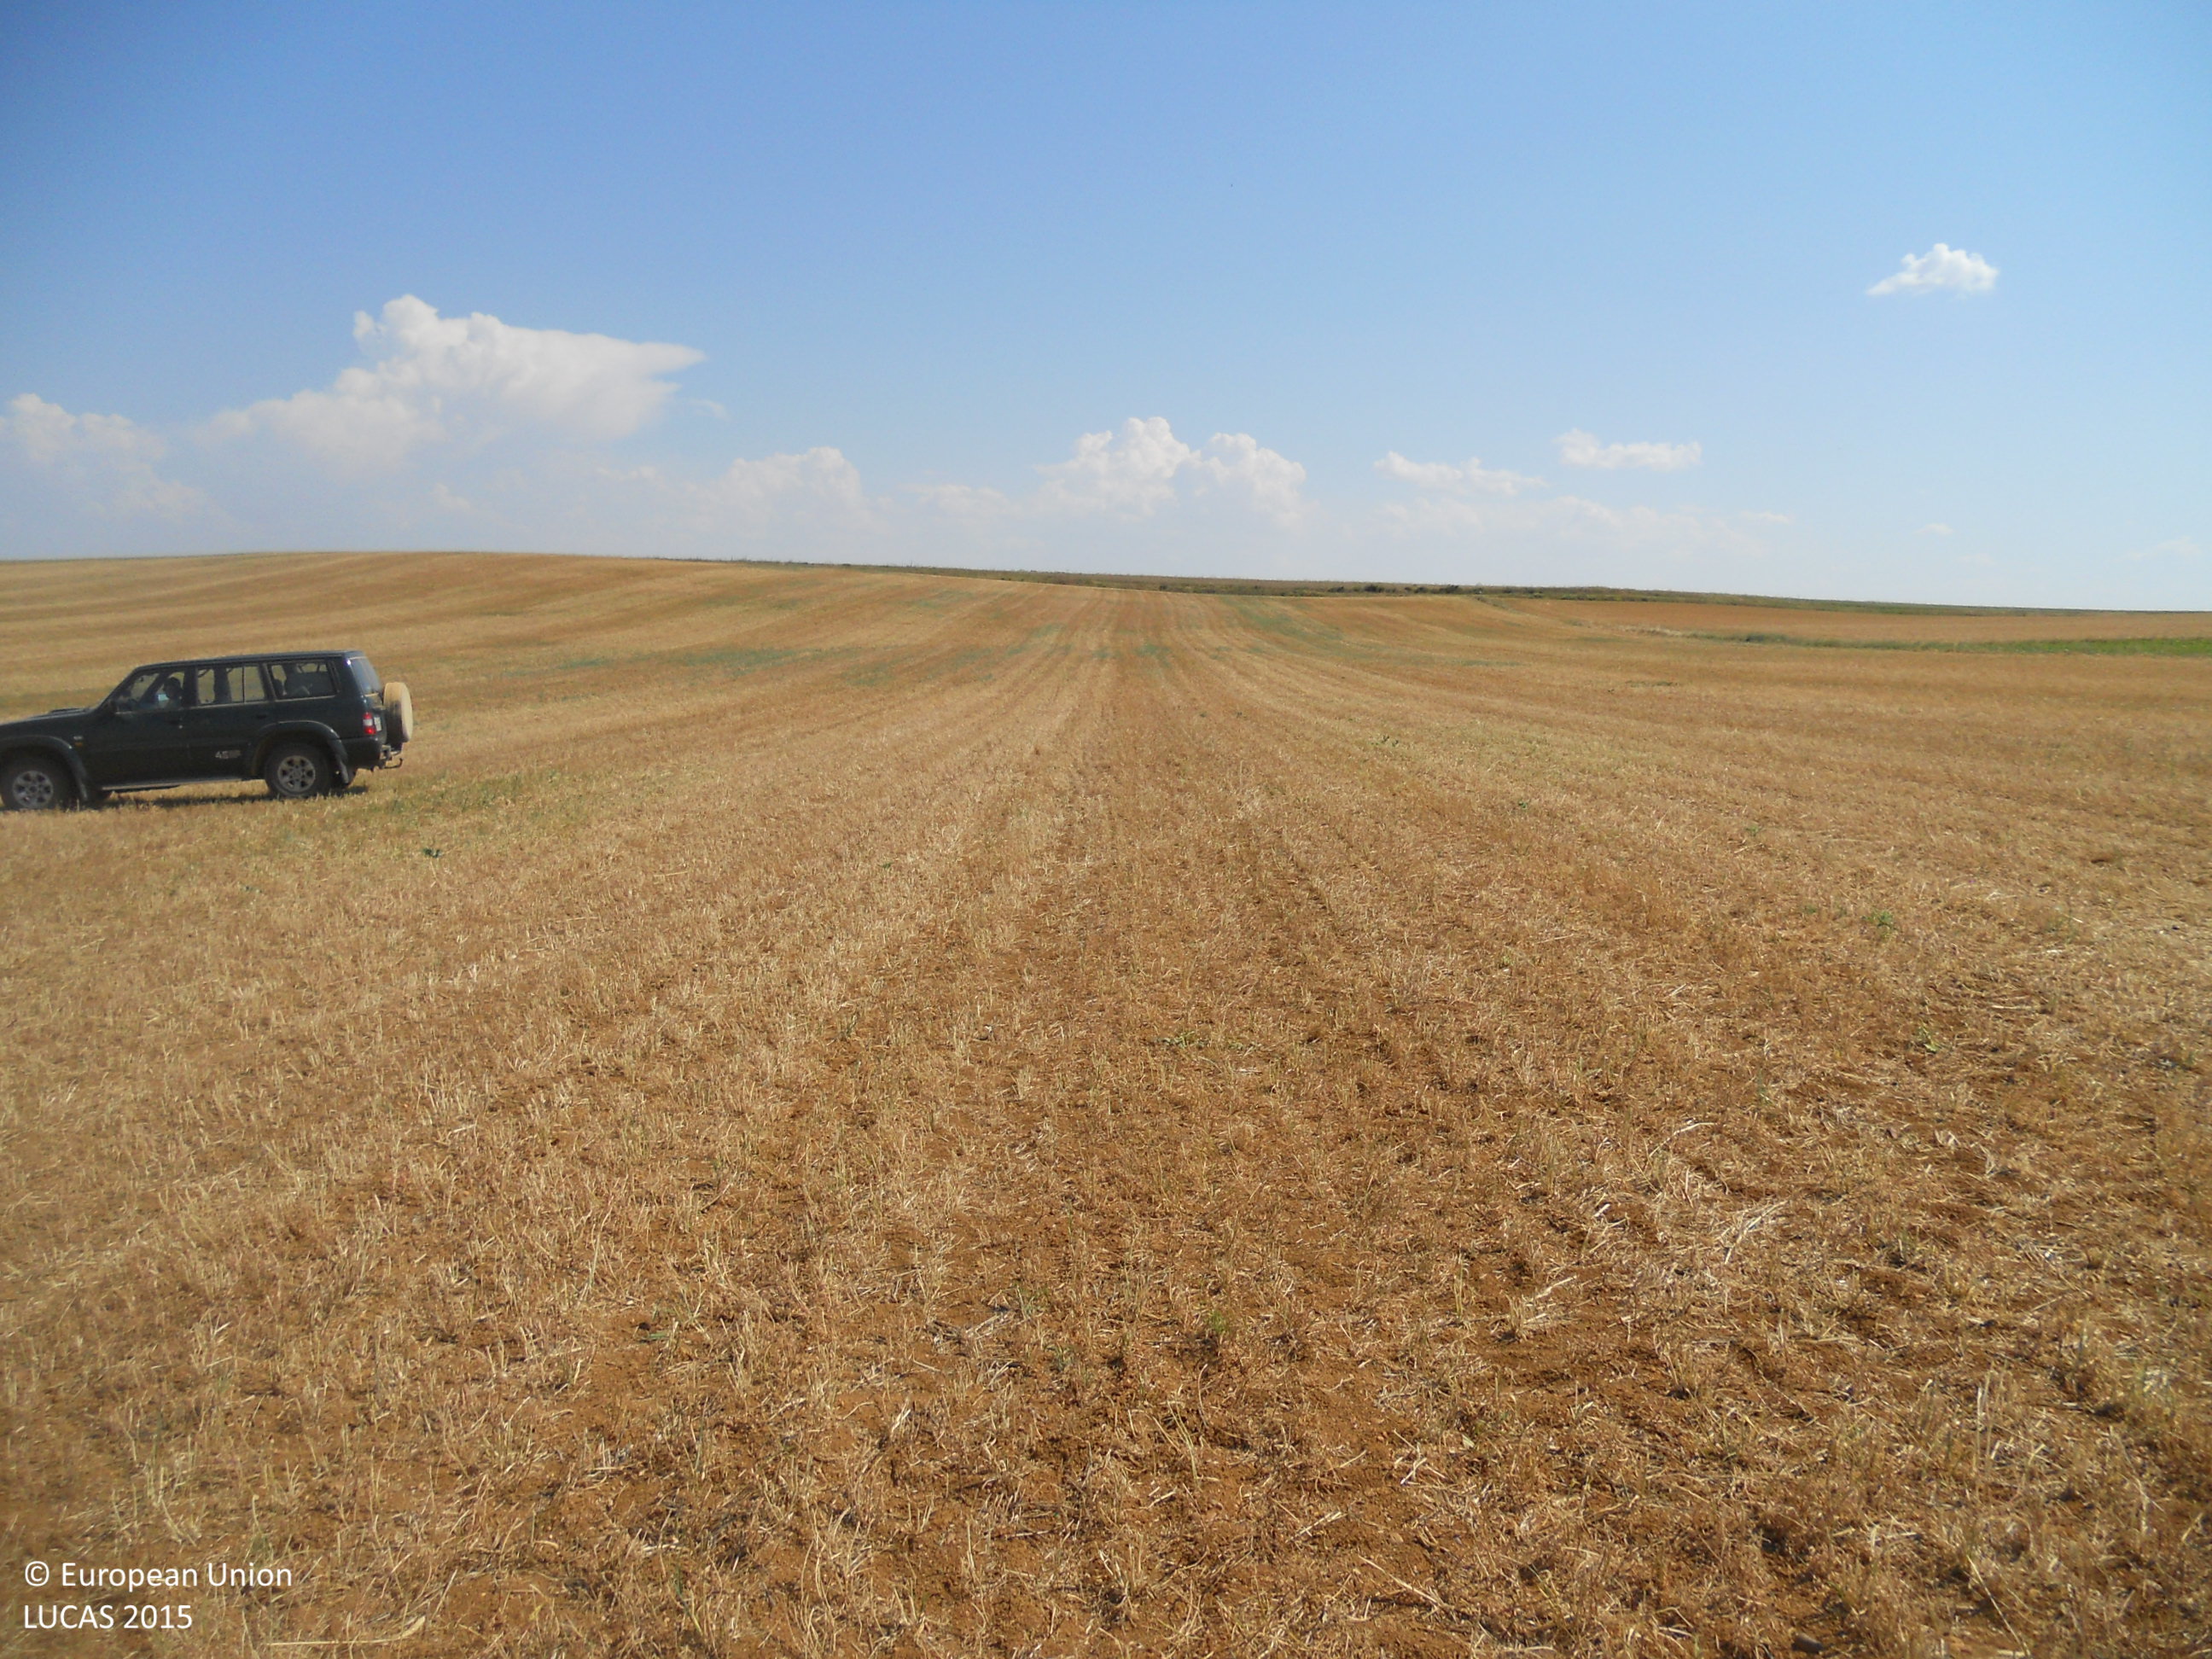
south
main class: Cropland
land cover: Mixed cereals for fodder
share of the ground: < 10 %
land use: Agriculture (excluding fallow land and kitchen gardens)
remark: Harvested field
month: June
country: ES
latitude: 42.1897
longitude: -5.4805
